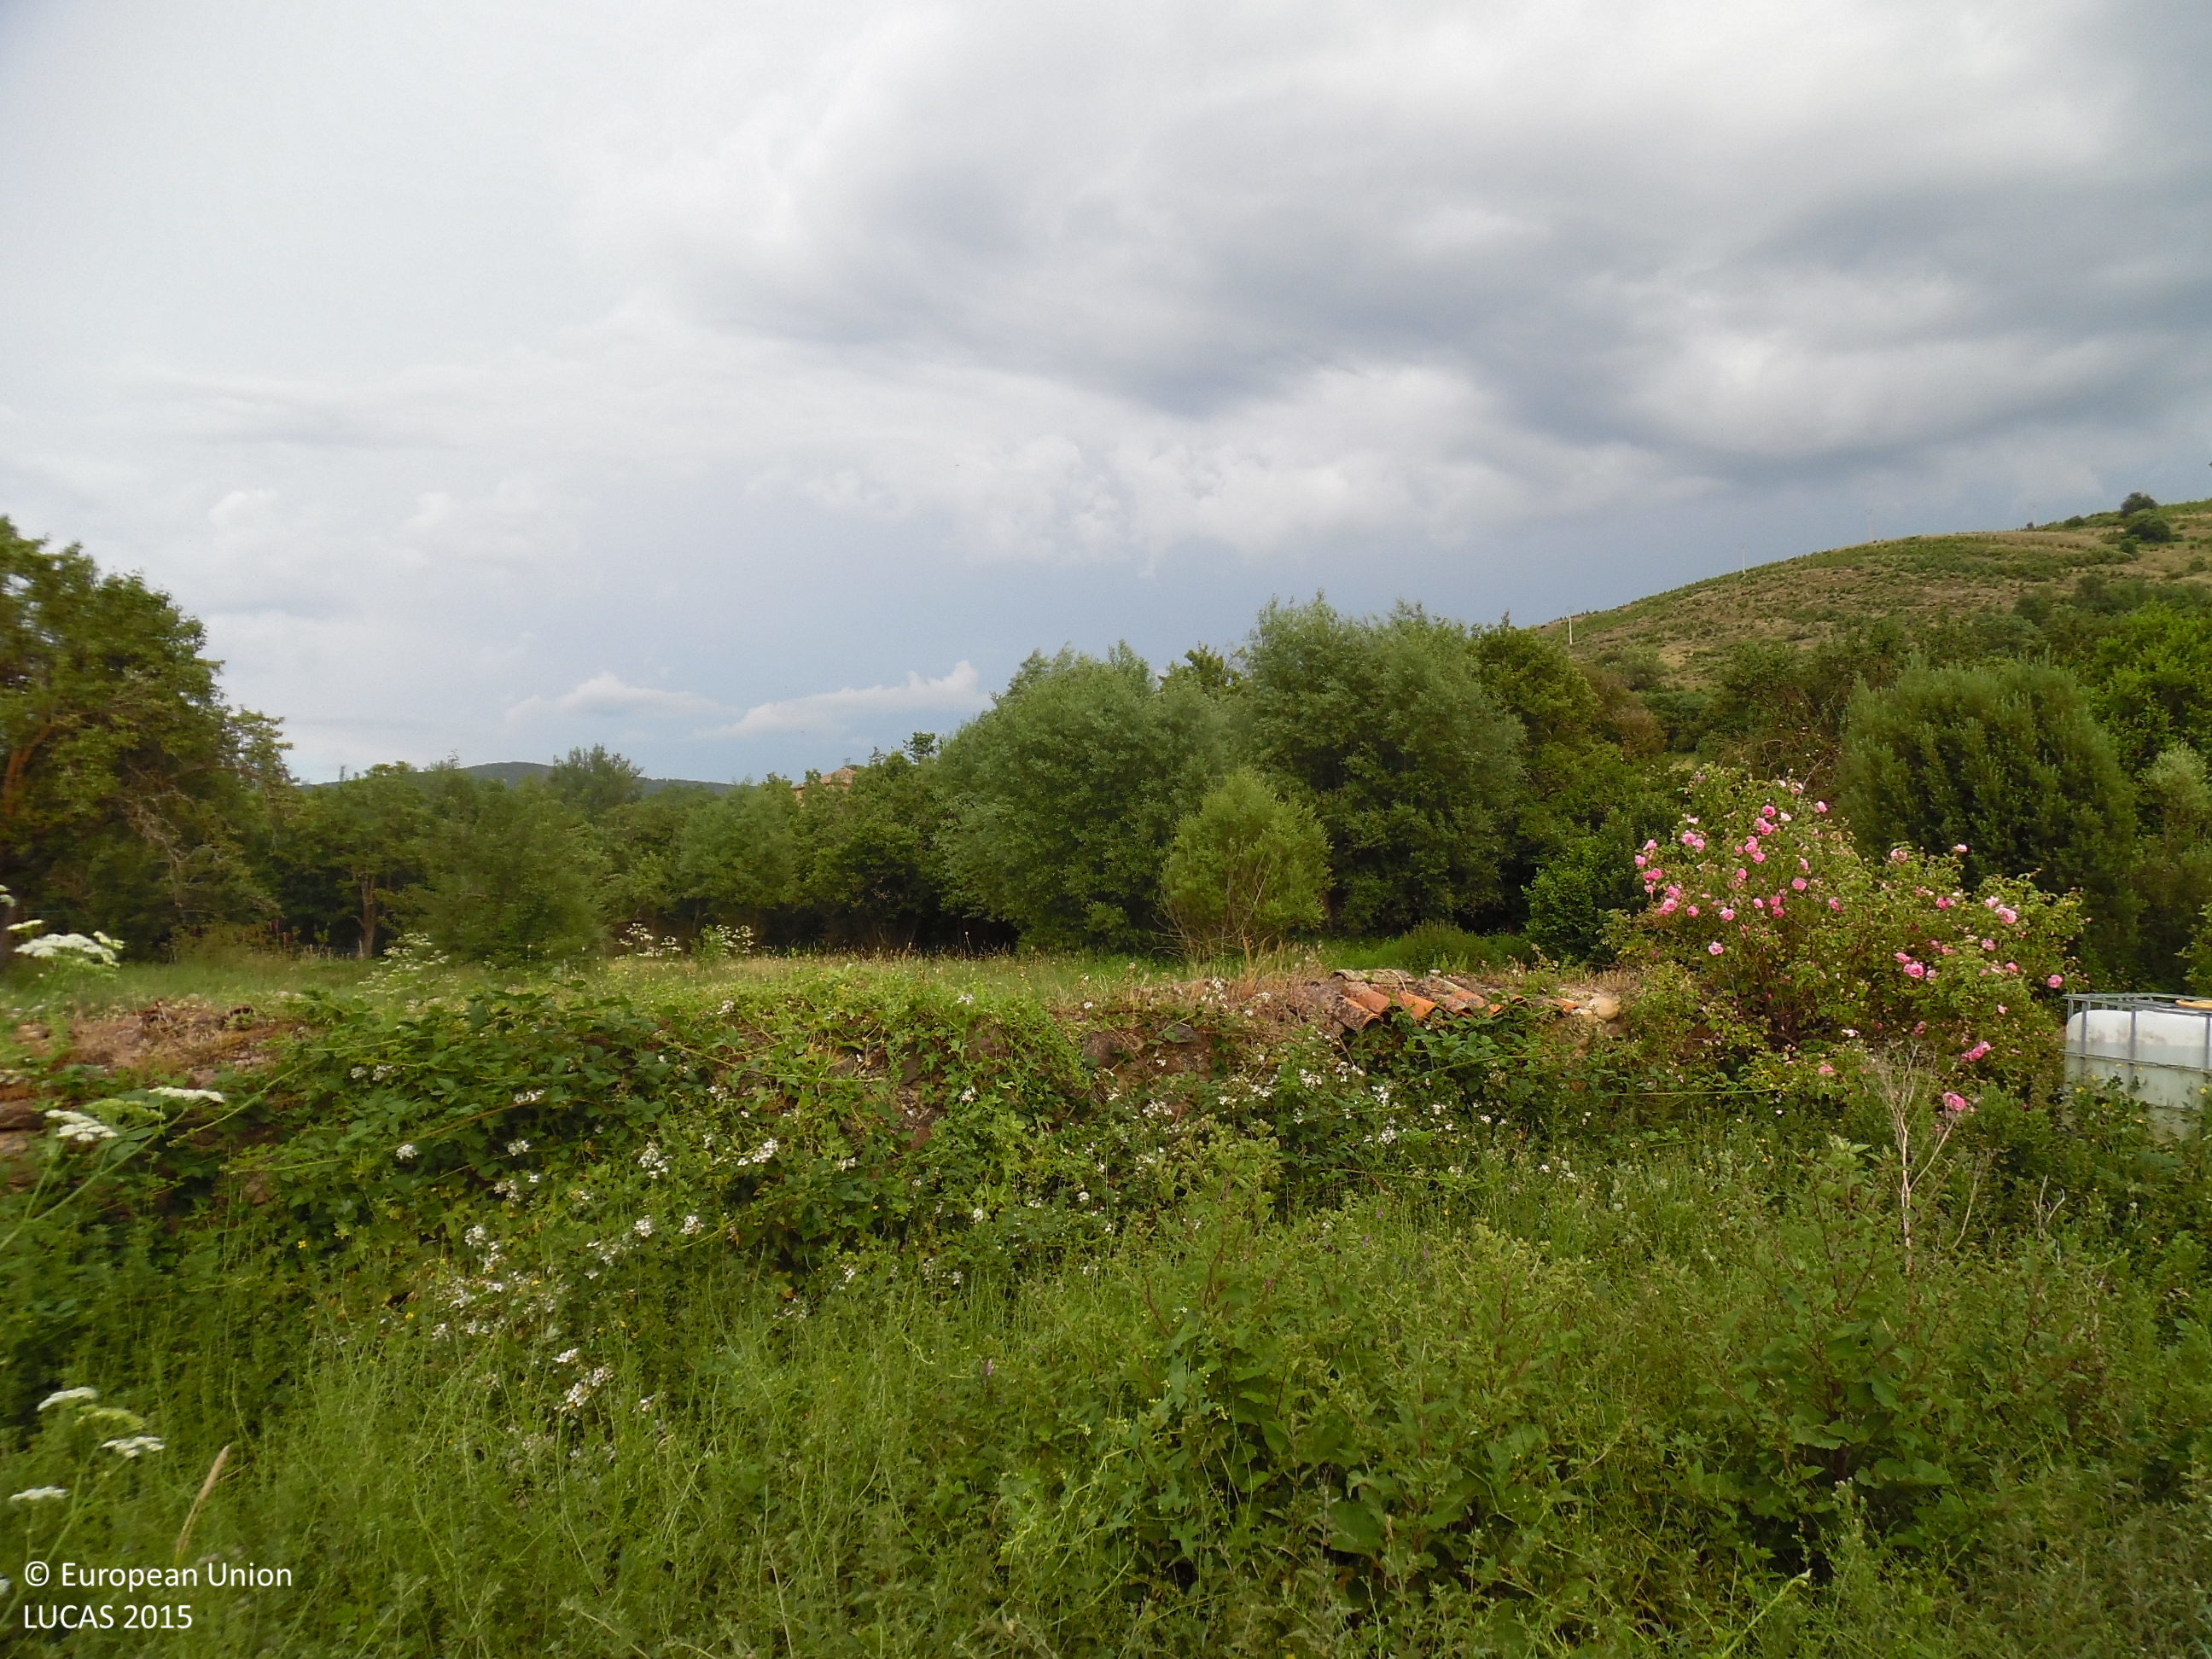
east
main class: Grassland
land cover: Spontaneously vegetated surfaces
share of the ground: > 75 %
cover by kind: herbaceous plants 95 %, shrubs 5 %
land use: Abandoned areas
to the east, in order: Spontaneously vegetated surfaces; Dry stone walls; Potatoes; Spontaneously vegetated surfaces; Other fresh vegetables; Dry stone walls; Grassland with sparse tree/shrub cover; Potatoes; Grassland with sparse tree/shrub cover; Tracks; Grass margins; Ditches and canals; Grass margins; Dry stone walls; Groves; Grassland without tree/shrub cover; Groves; Dry stone walls; Artificial constructions in urban areas; Grassland without tree/shrub cover
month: June
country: ES
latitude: 42.7702
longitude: -5.7587
